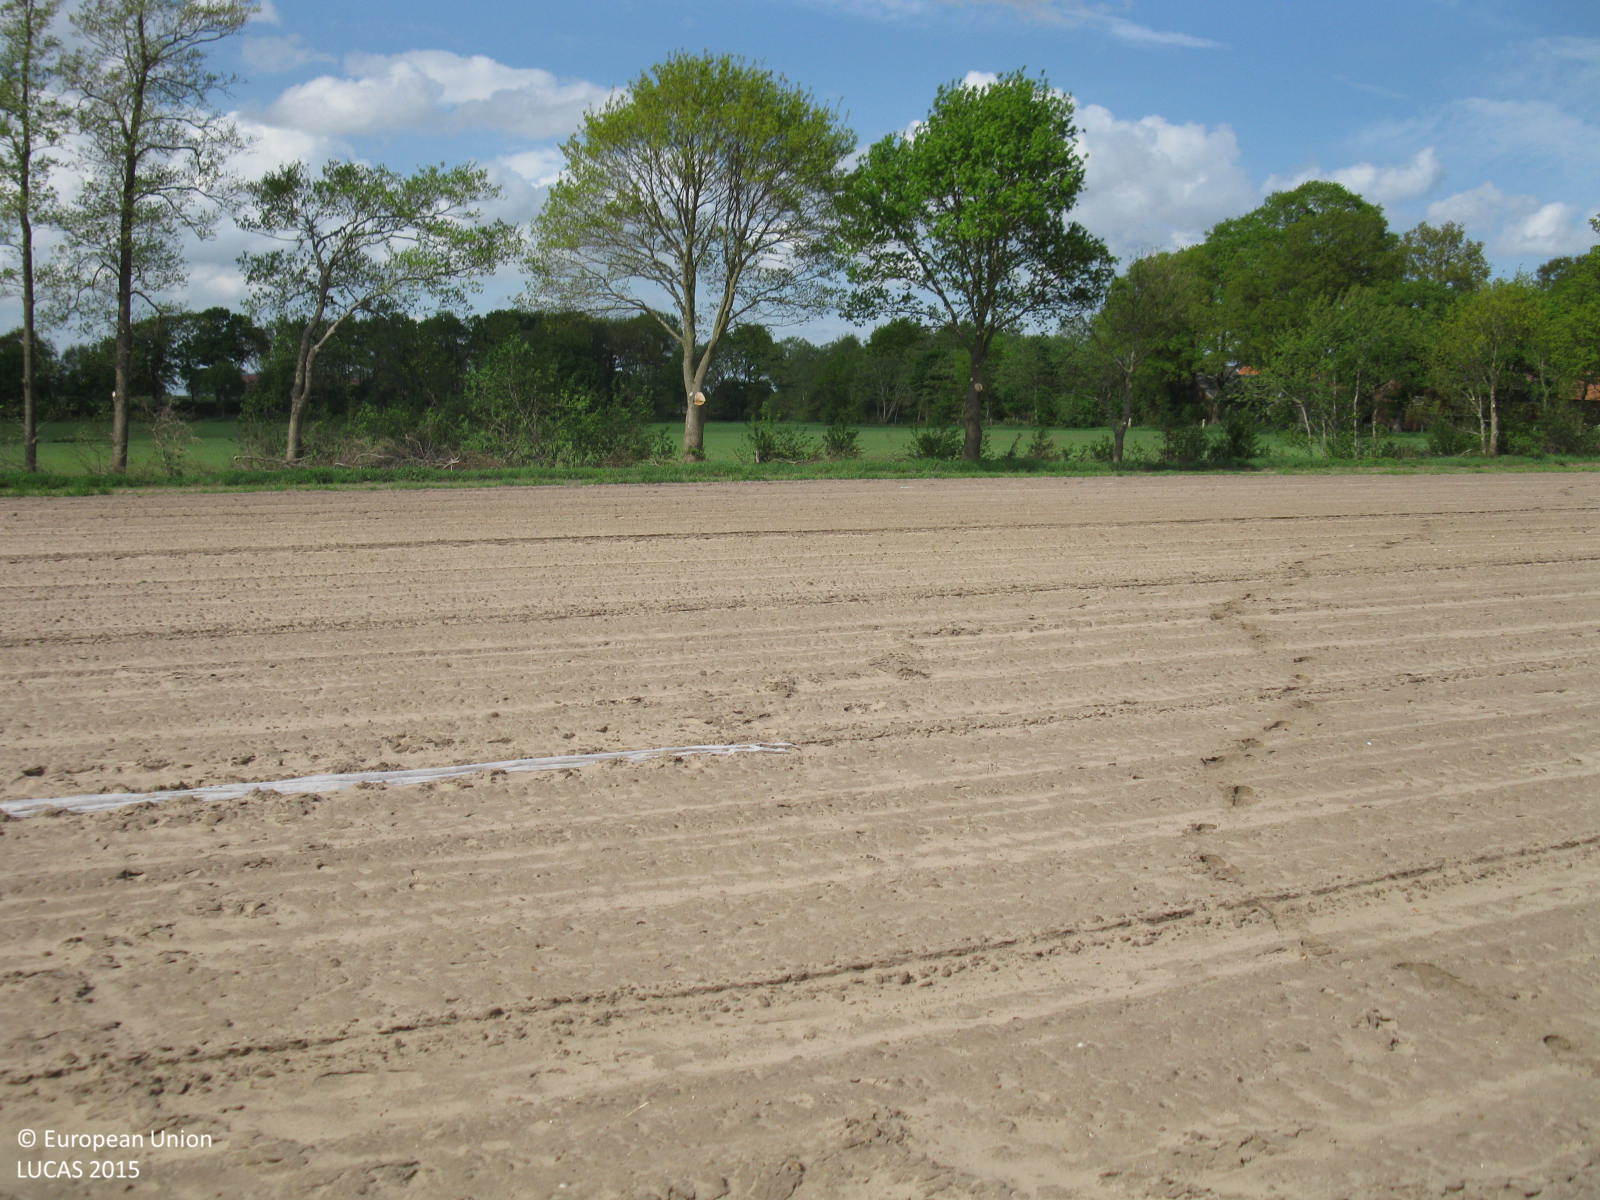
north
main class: Cropland
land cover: Other fresh vegetables
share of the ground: 25 - 50 %
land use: Agriculture (excluding fallow land and kitchen gardens)
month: May
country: DE
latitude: 52.9950
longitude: 7.3336
